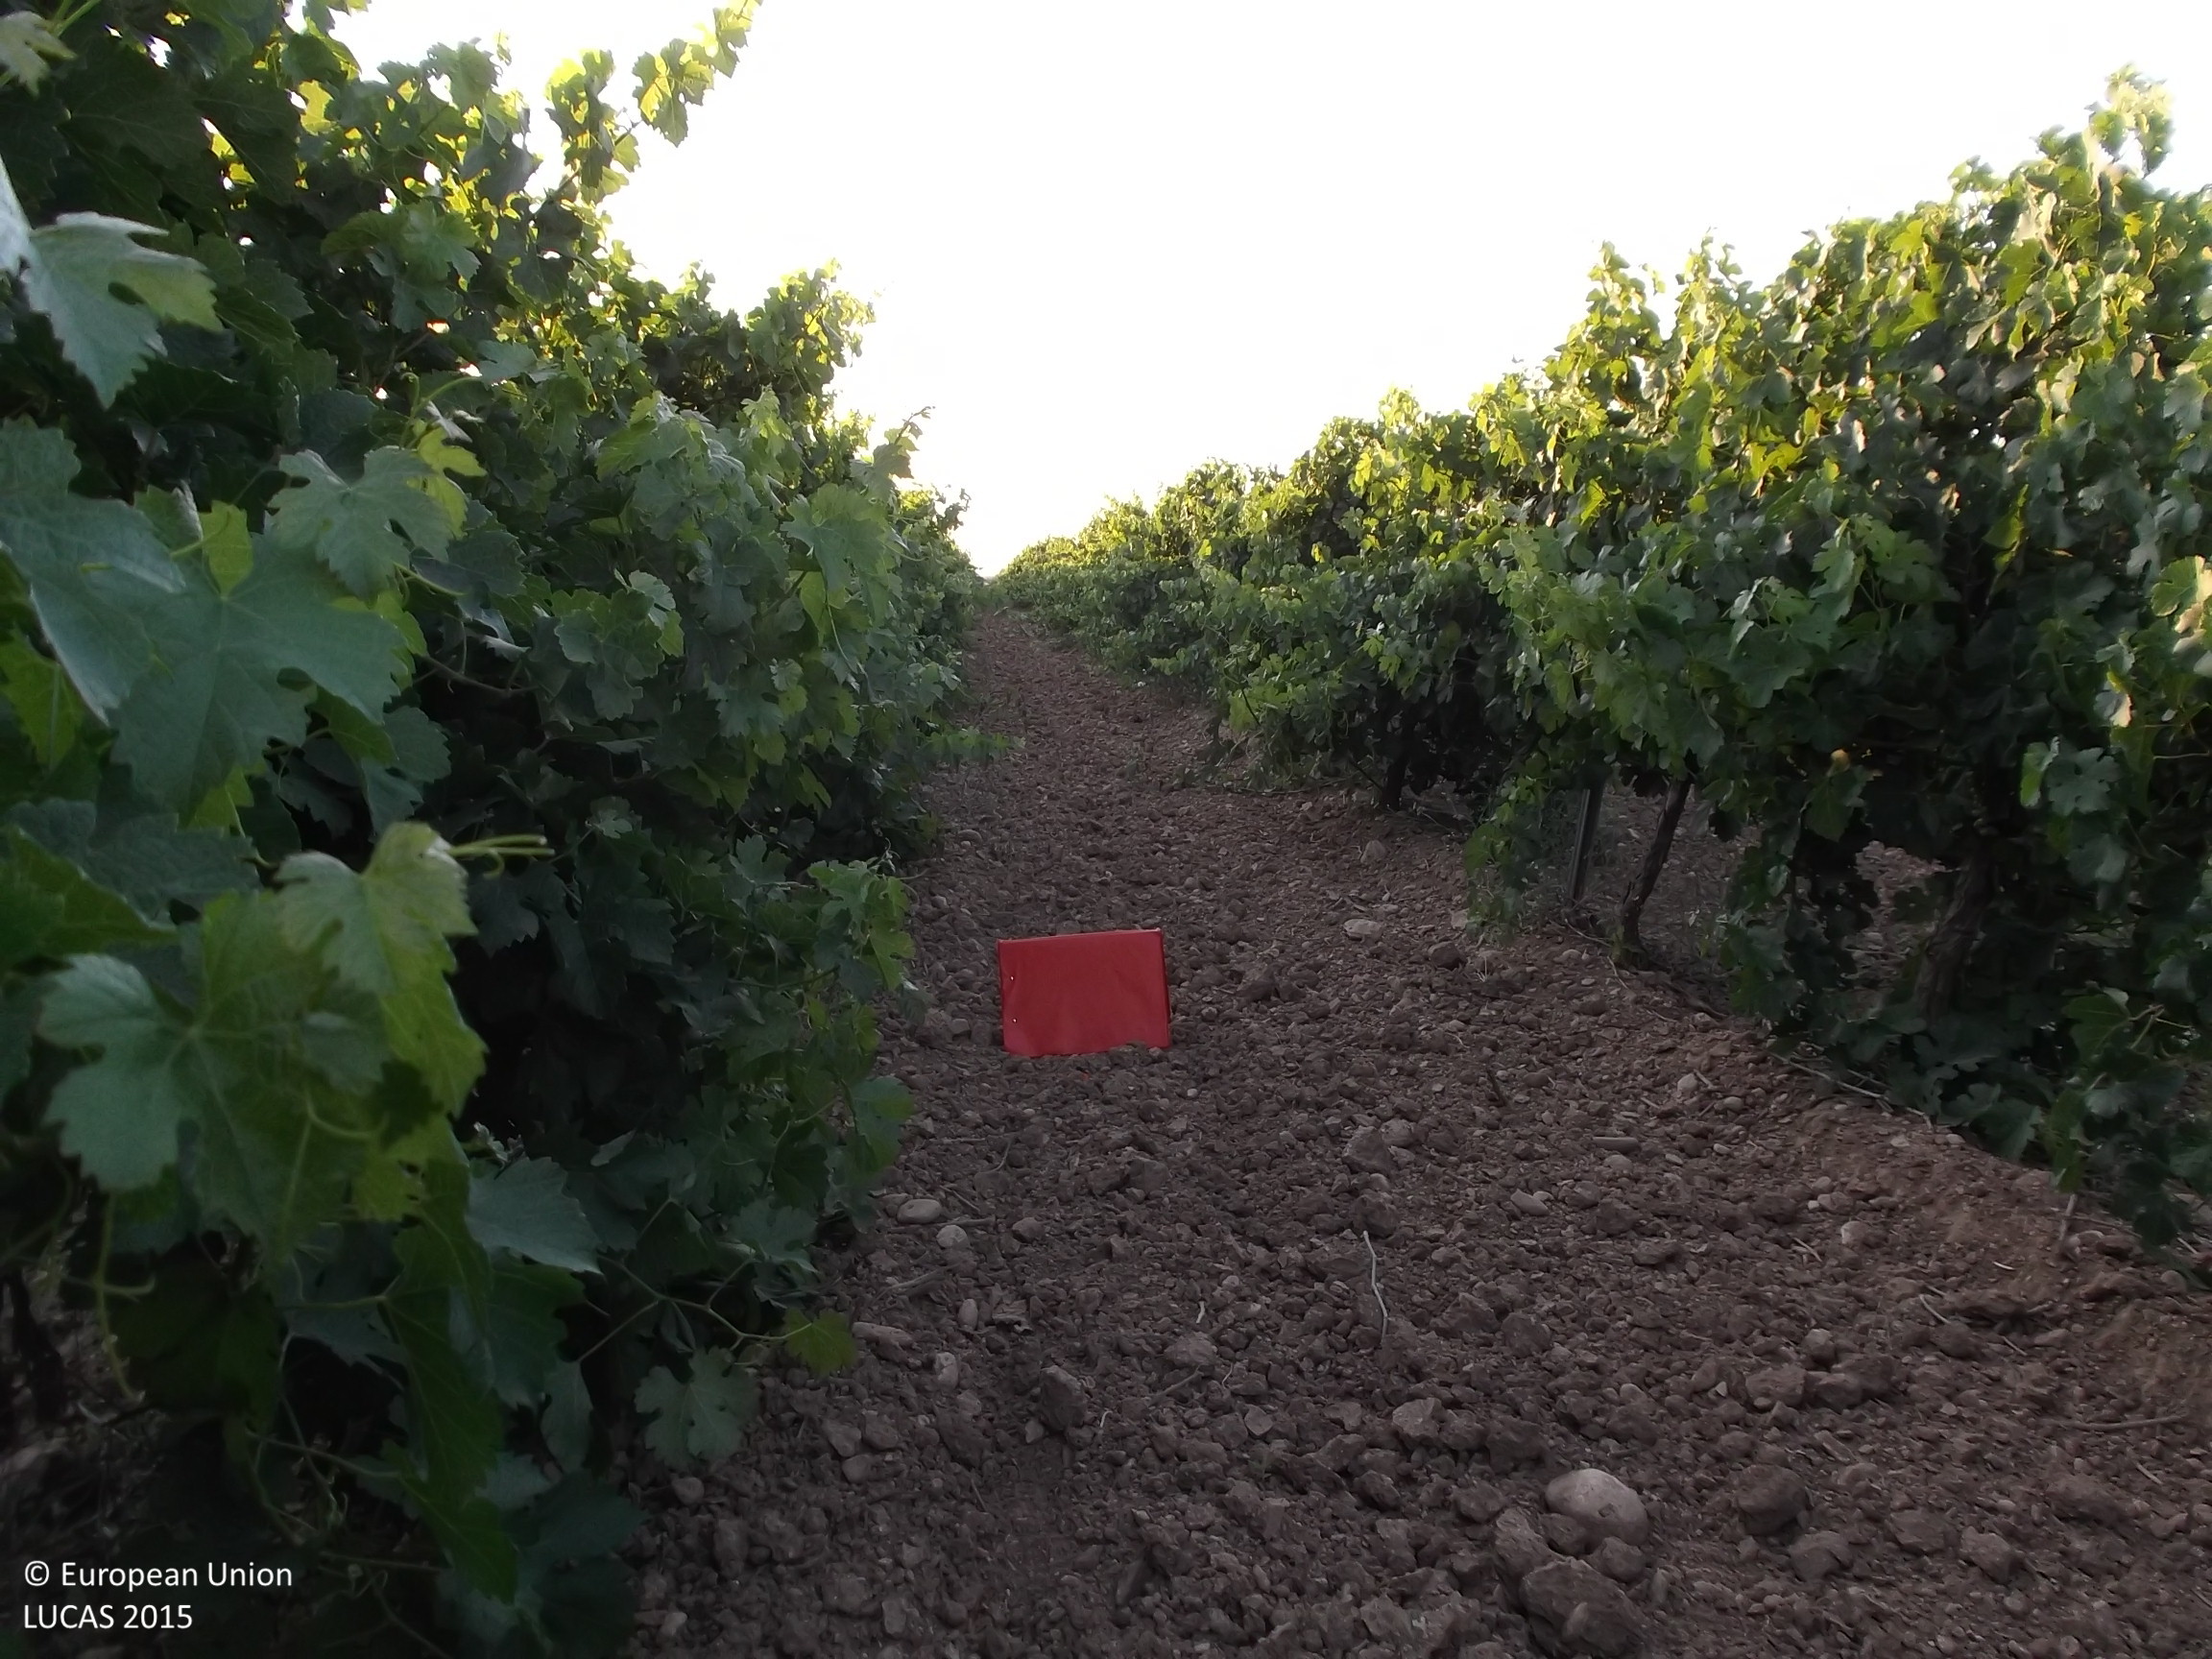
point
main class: Cropland
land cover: Vineyards
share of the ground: 10 - 25 %
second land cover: Other bare soil
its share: > 75 %
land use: Agriculture (excluding fallow land and kitchen gardens)
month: July
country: ES
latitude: 42.4356
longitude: -1.6447
